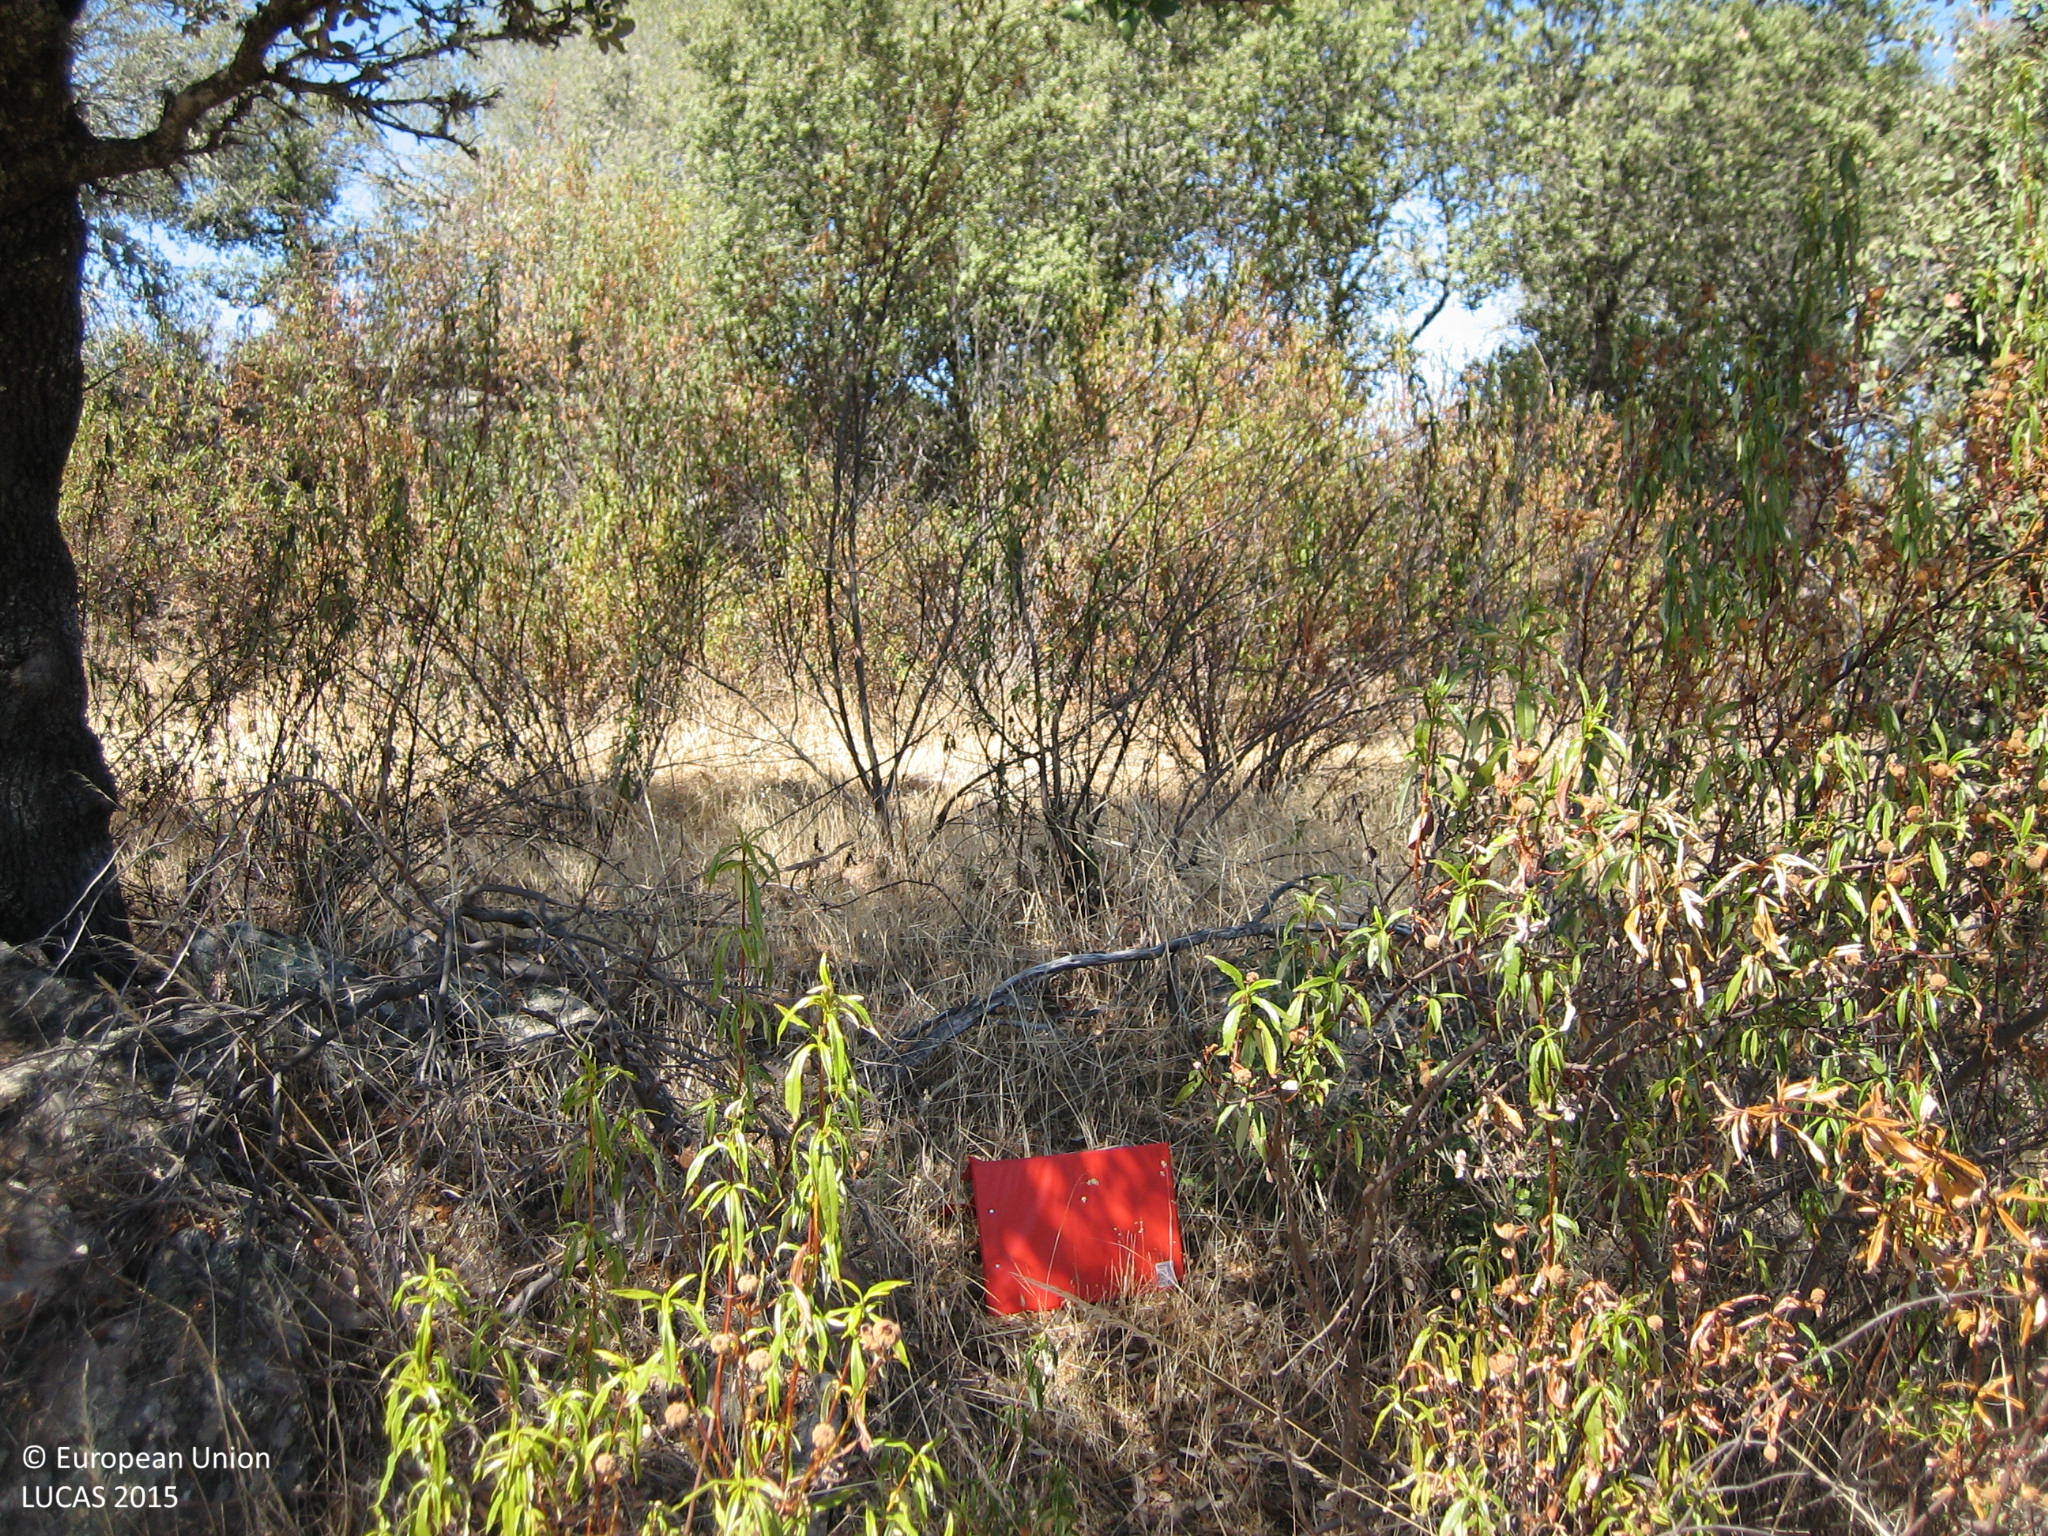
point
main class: Shrubland
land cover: Shrubland with sparse tree cover
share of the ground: 50 - 75 %
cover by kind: shrubs 60 %, herbaceous plants 35 %, broadleaved forest trees 5 %
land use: Agriculture (excluding fallow land and kitchen gardens)
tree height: < 5 m
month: August
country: ES
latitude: 38.4546
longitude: -7.2217
